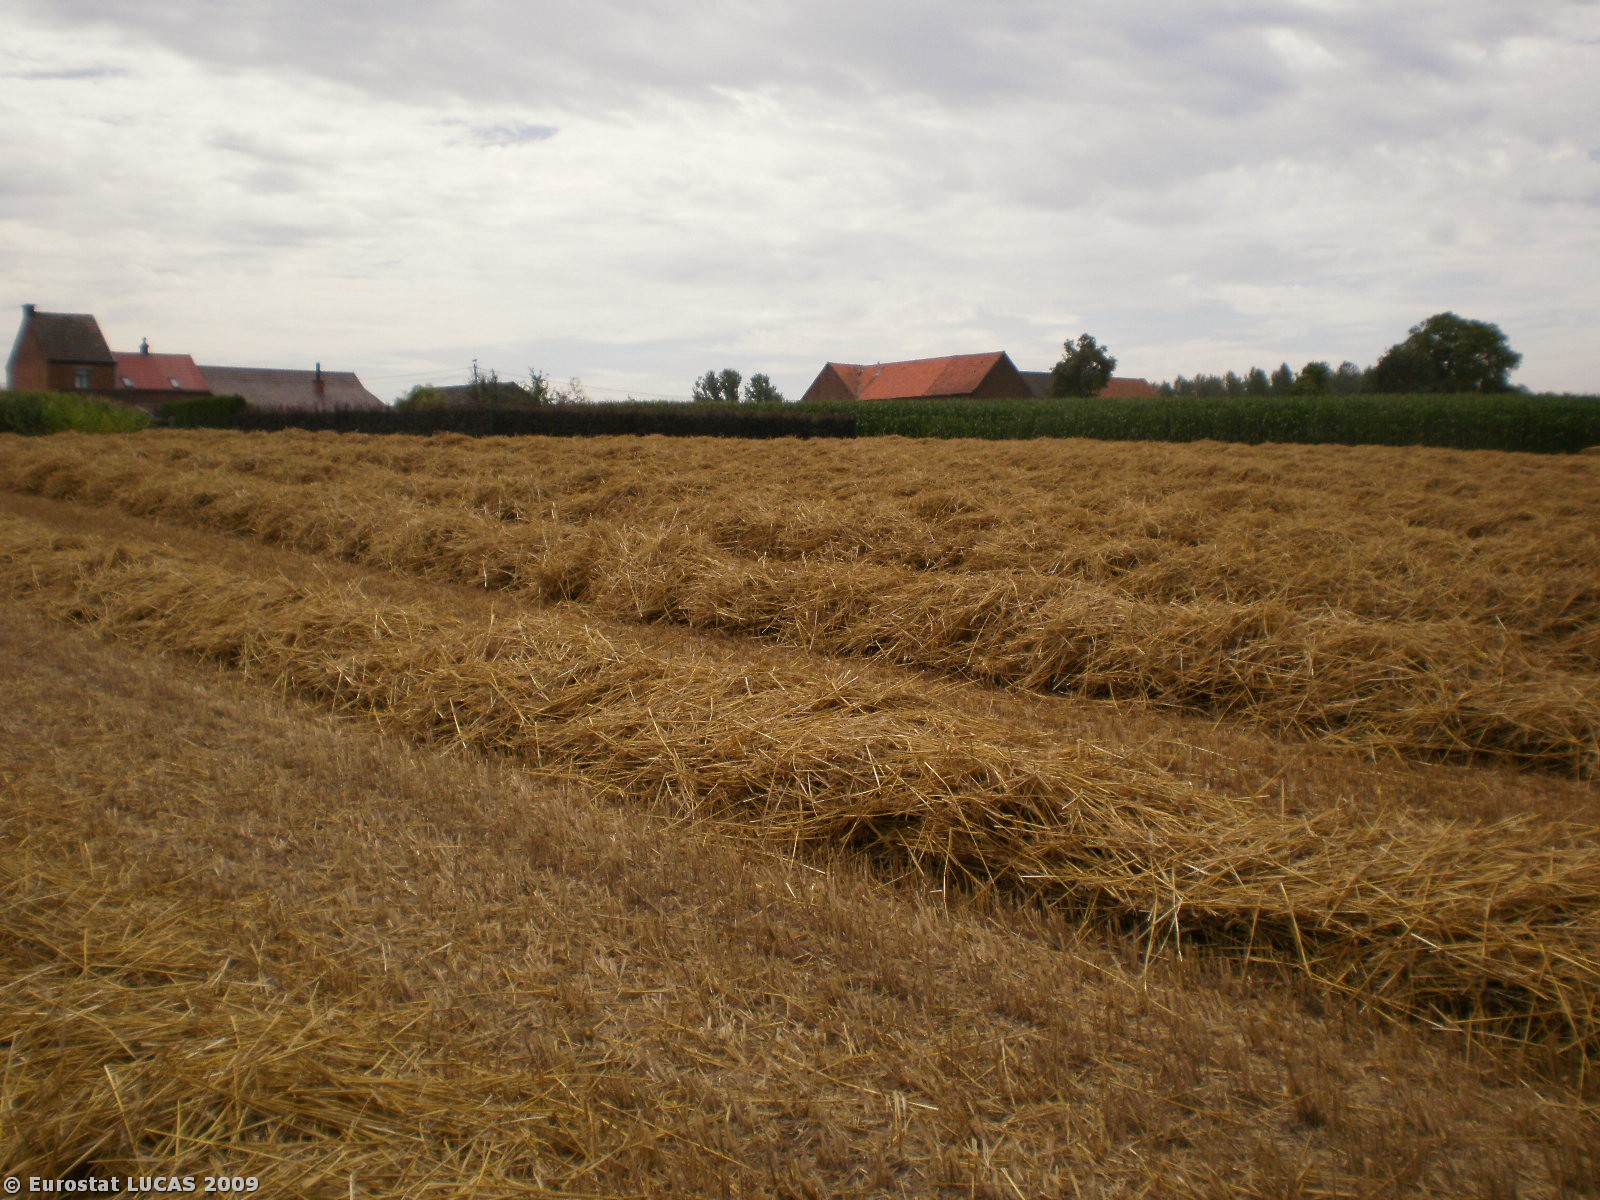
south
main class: Cropland
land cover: Common wheat
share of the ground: > 75 %
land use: Agriculture (excluding fallow land and kitchen gardens)
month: August
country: BE
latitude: 50.7564
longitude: 3.8272
